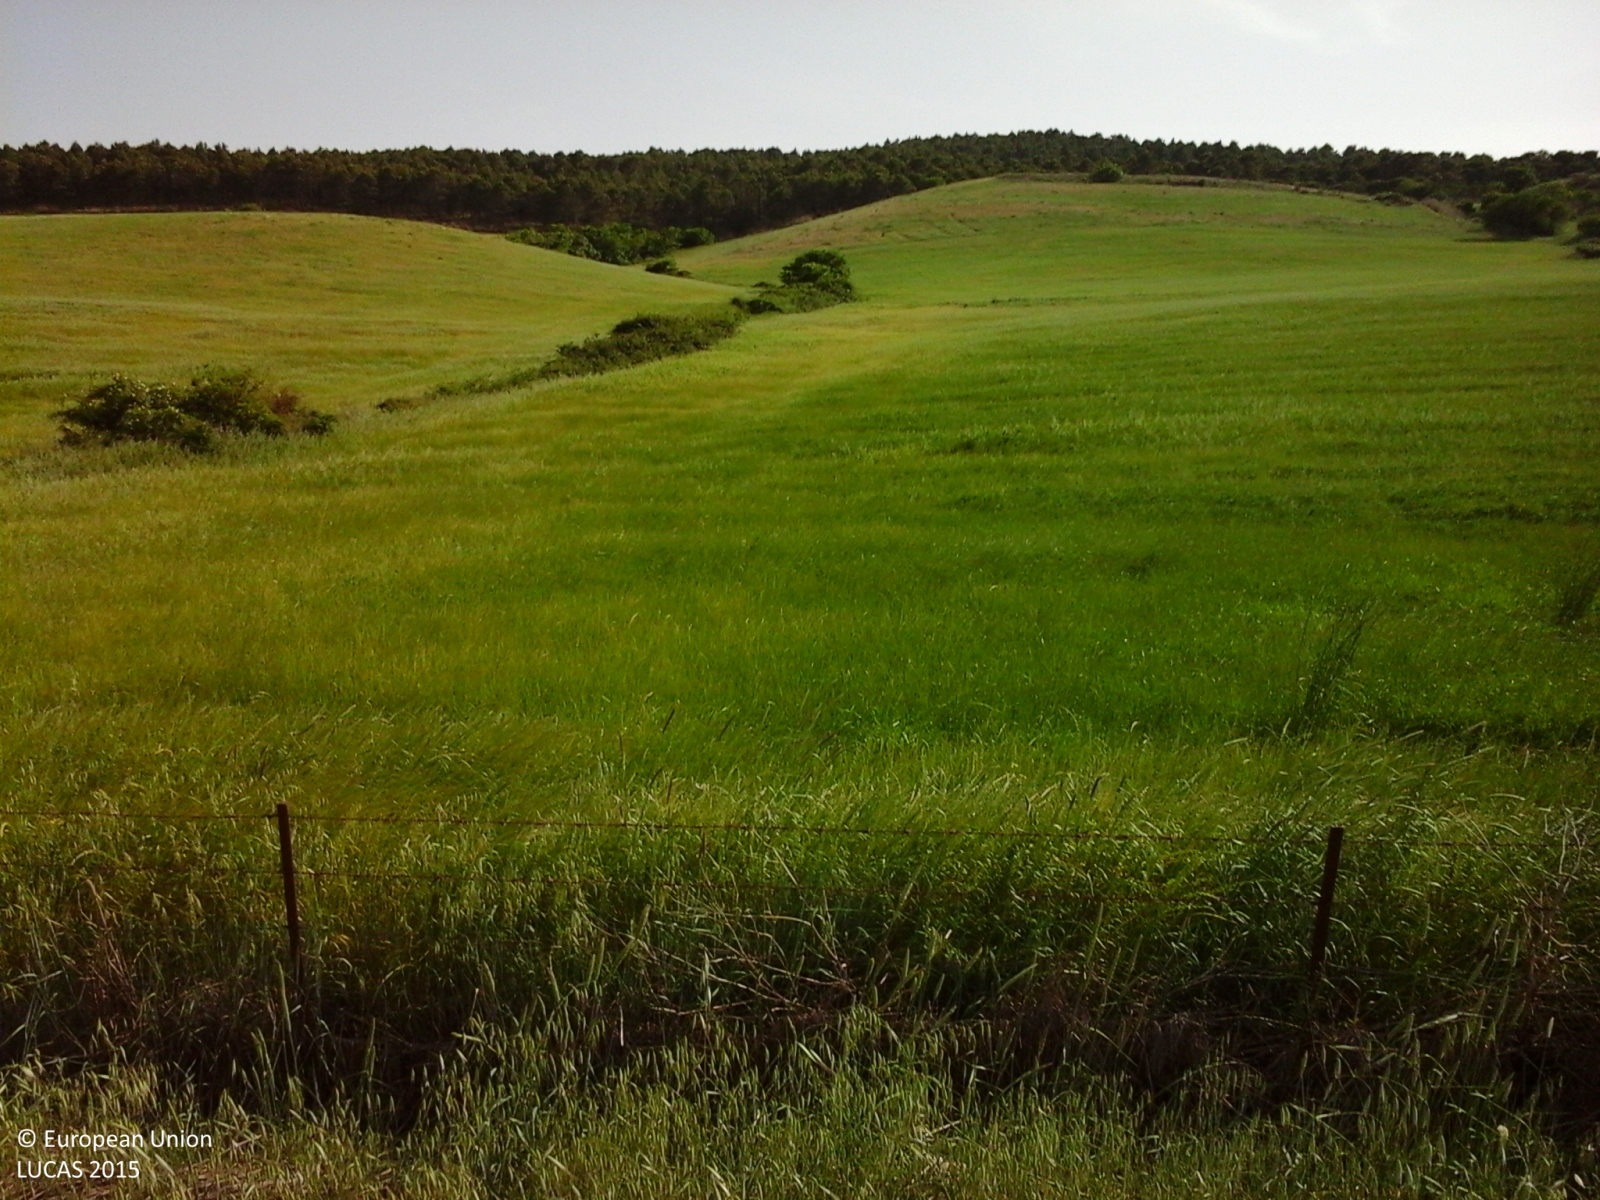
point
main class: Cropland
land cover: Mixed cereals for fodder
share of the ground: > 75 %
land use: Agriculture (excluding fallow land and kitchen gardens)
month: May
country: IT
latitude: 37.6452
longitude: 13.5437
